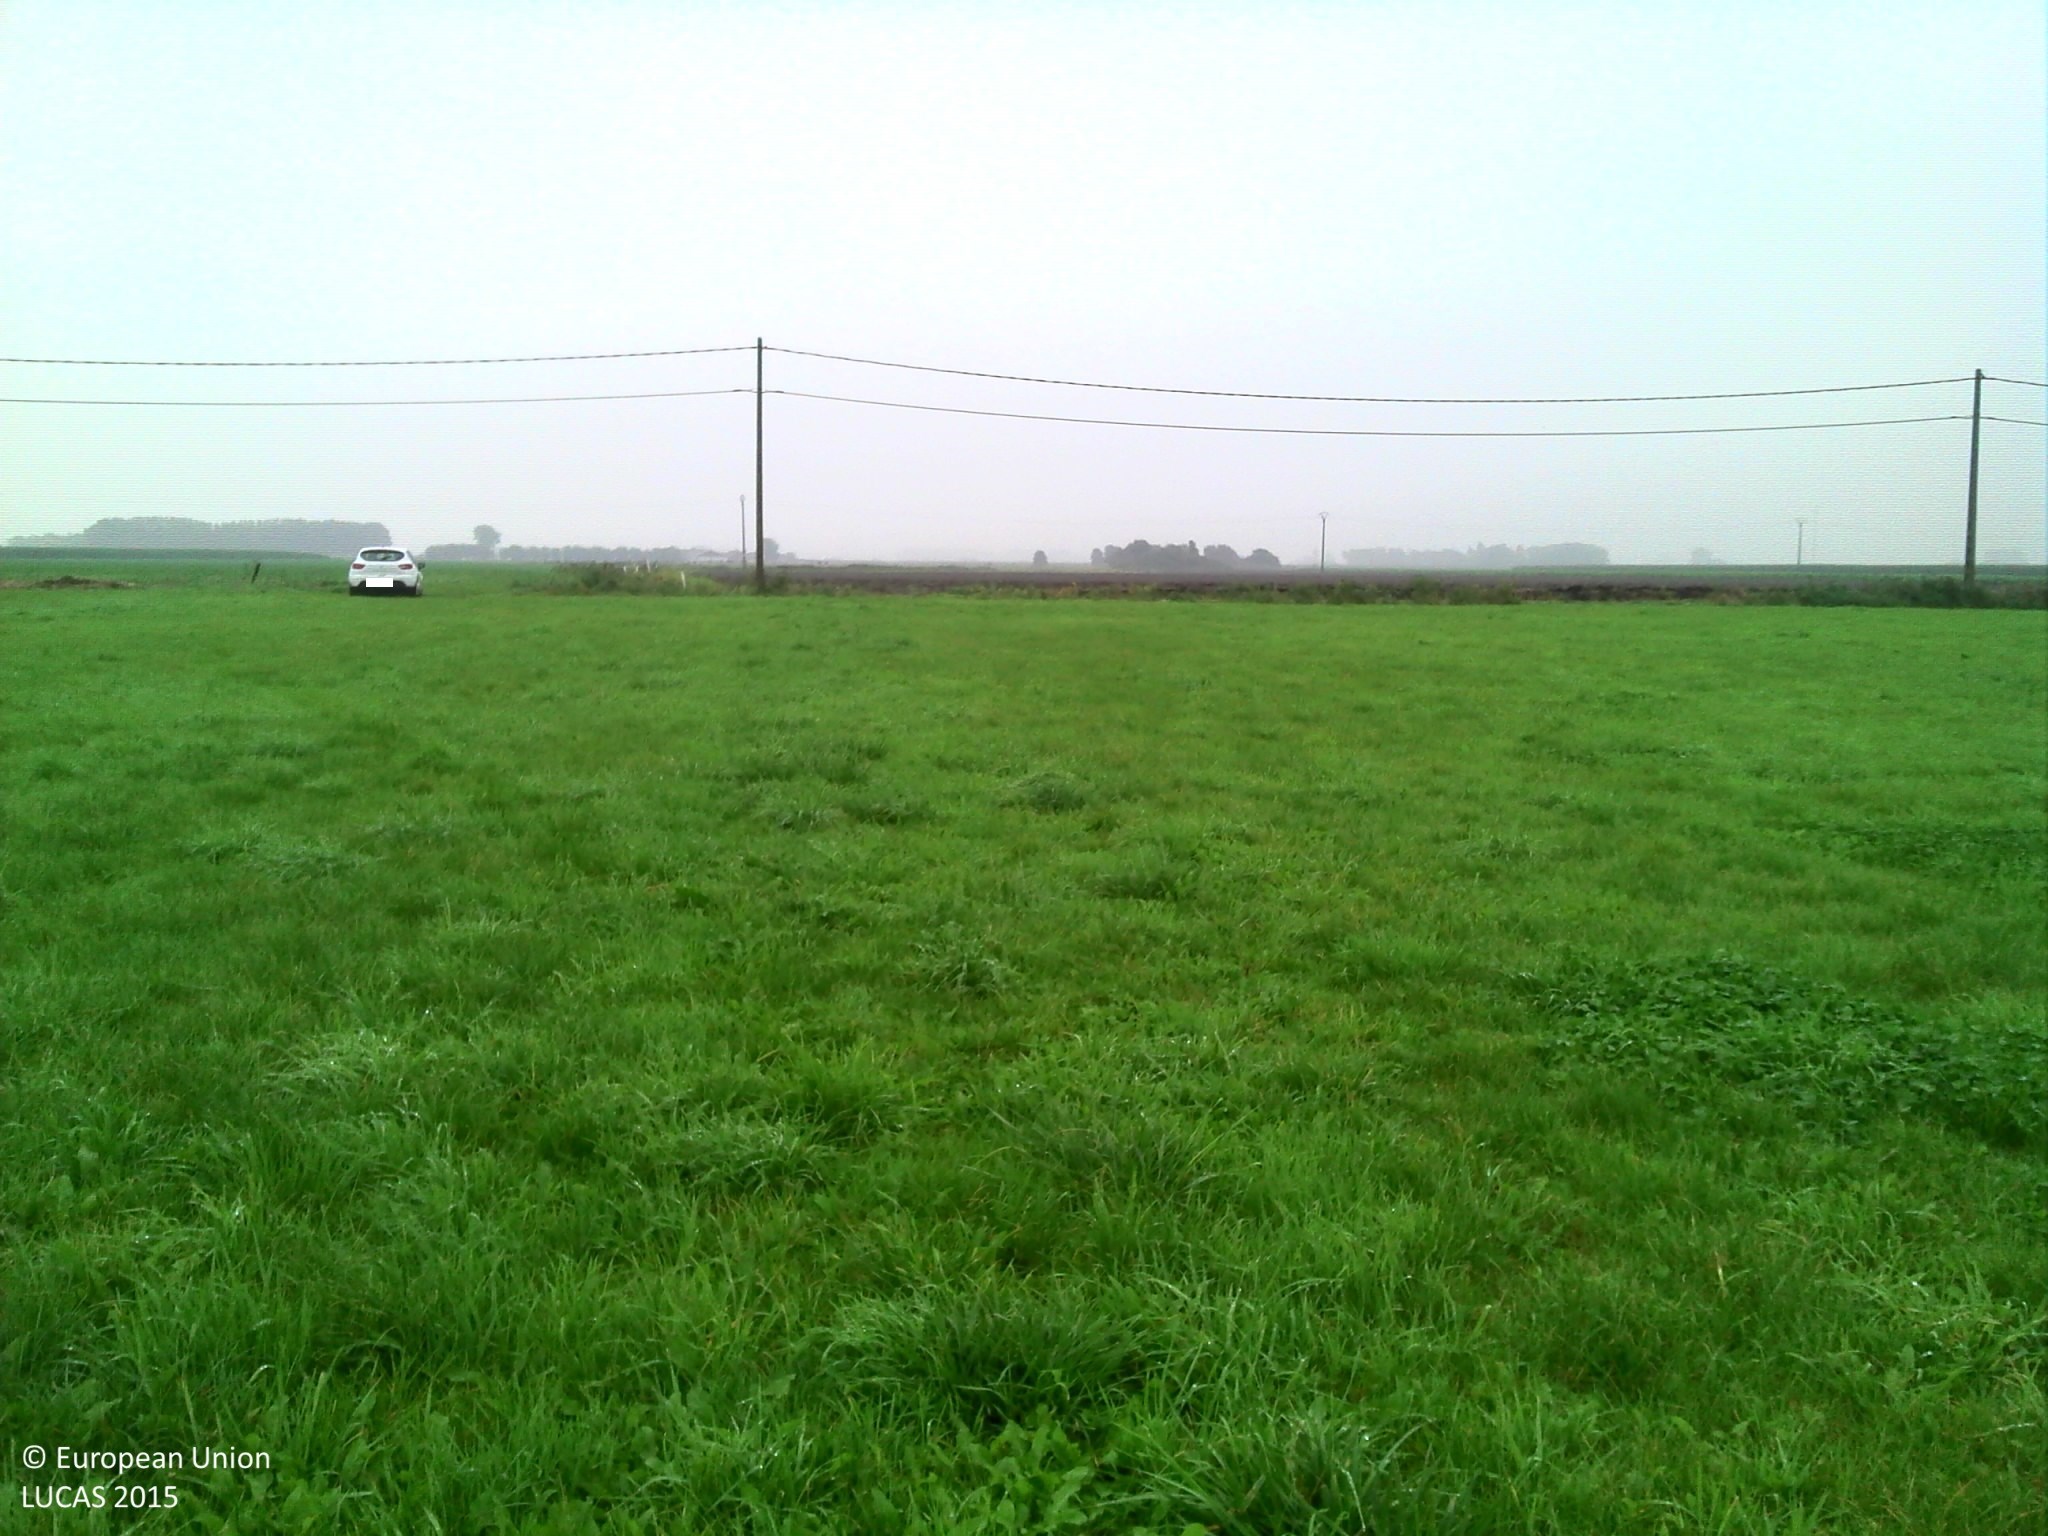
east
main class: Cropland
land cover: Temporary grasslands
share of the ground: > 75 %
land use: Agriculture (excluding fallow land and kitchen gardens)
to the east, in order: Temporary grasslands; Electric lines; Ditches and canals; Paved roads, cycling and walking lanes; Ditches and canals; Grass margins; Other bare soil
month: September
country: BE
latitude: 51.2154
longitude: 3.0179
